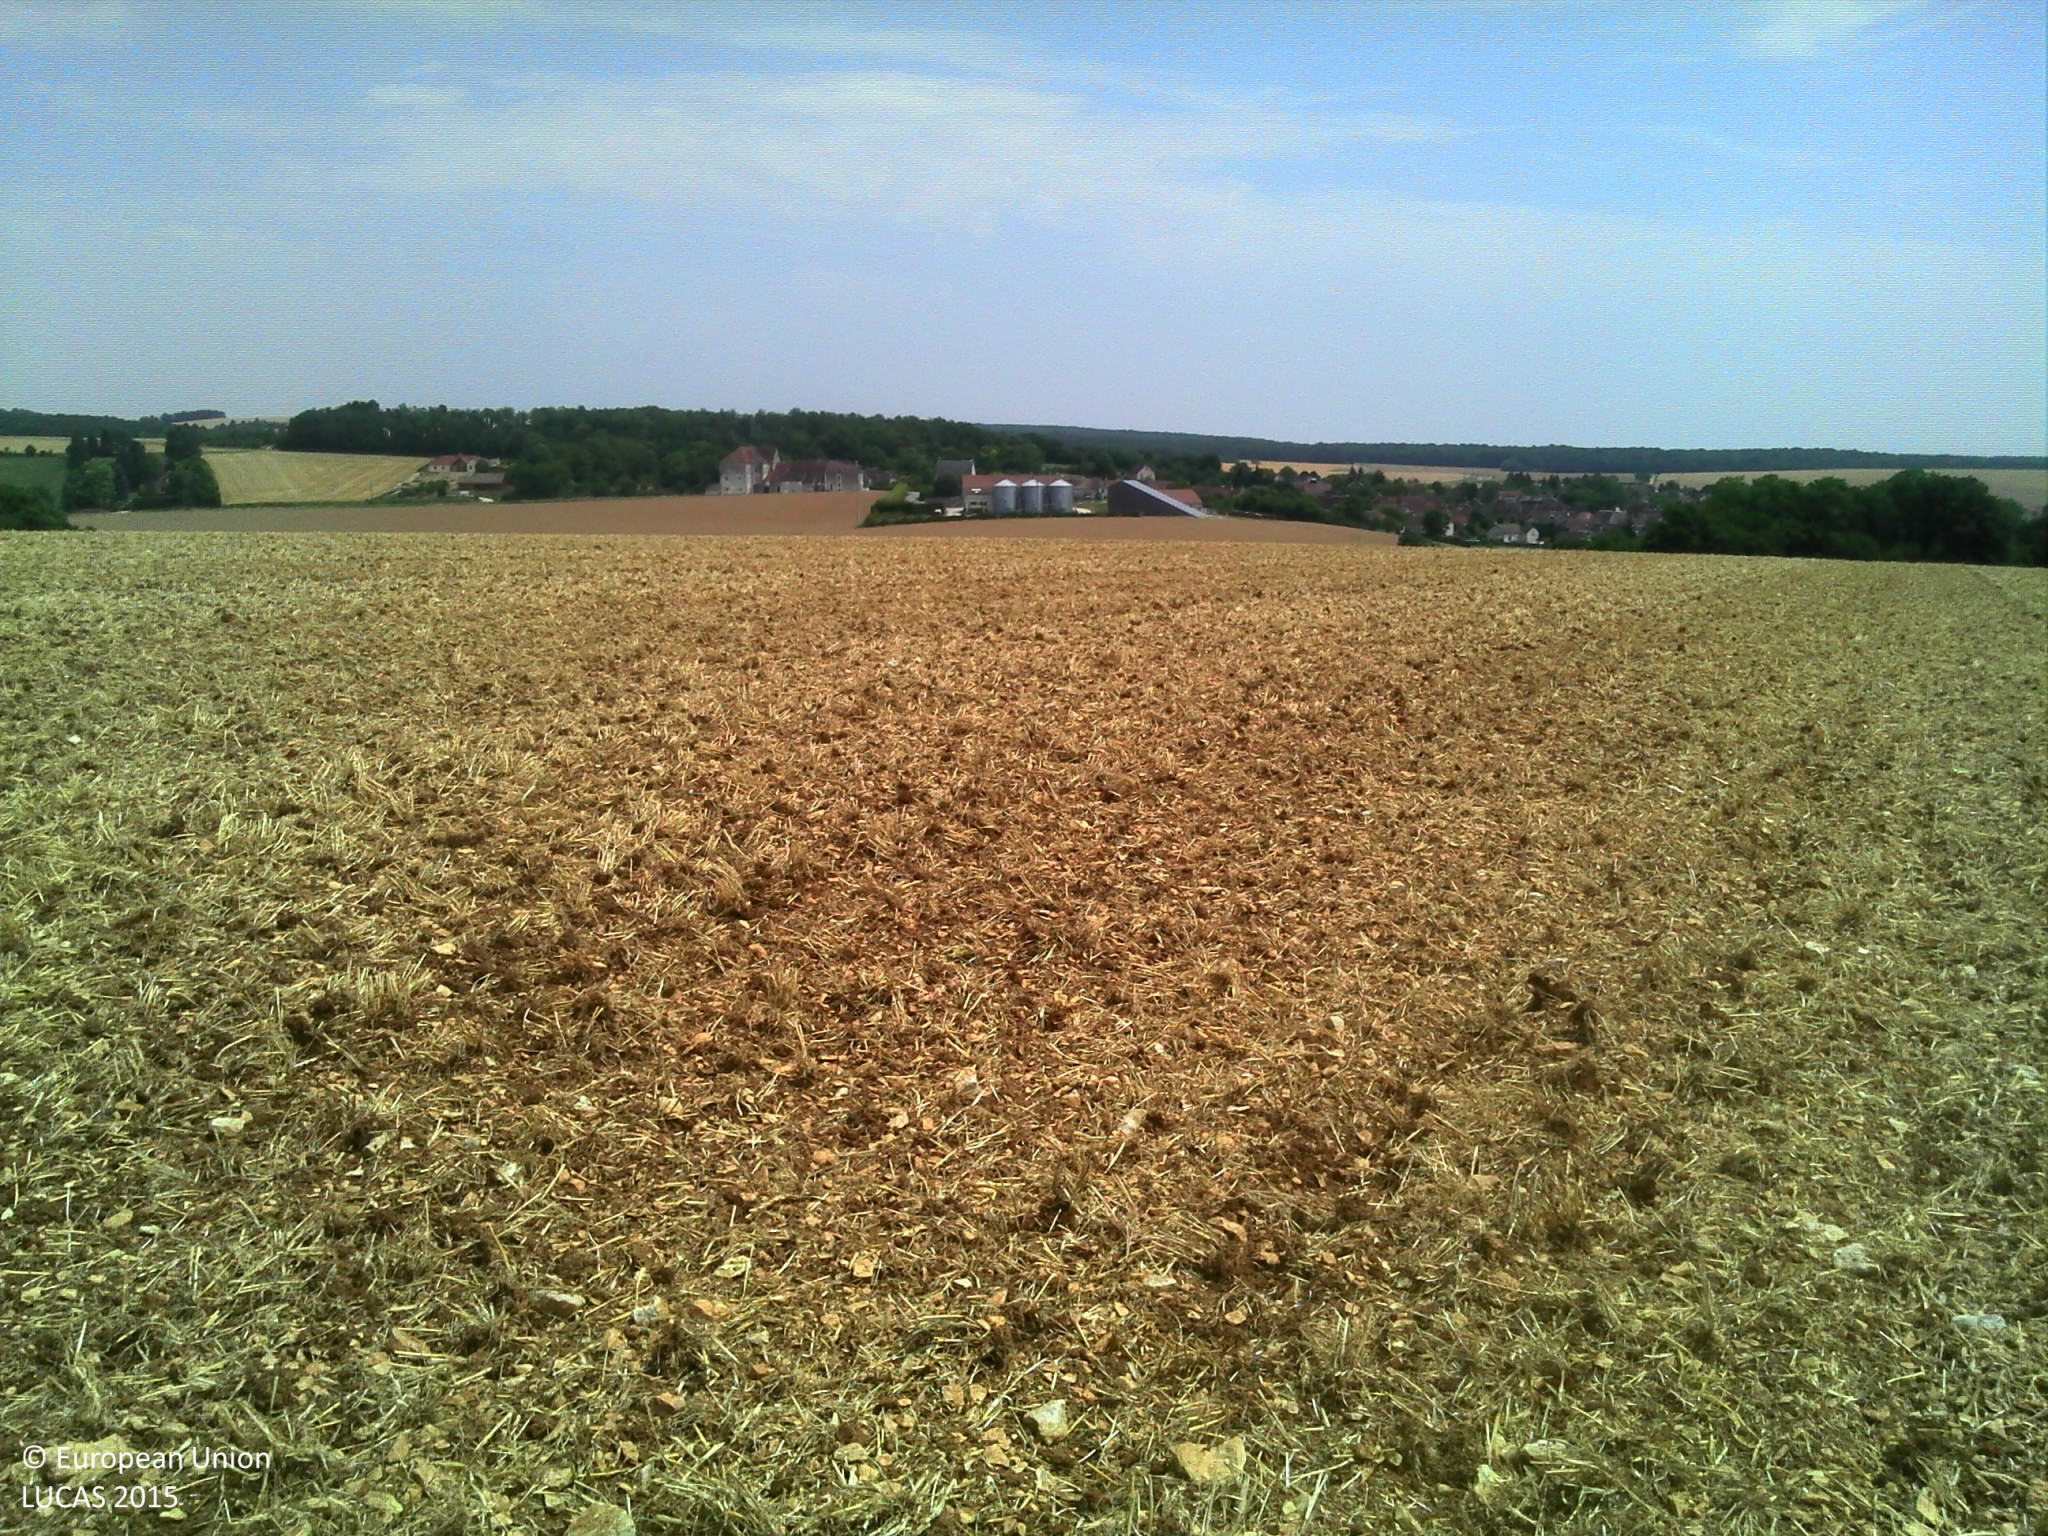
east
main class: Cropland
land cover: Barley
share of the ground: > 75 %
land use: Agriculture (excluding fallow land and kitchen gardens)
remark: Harvested field
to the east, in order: Barley
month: July
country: FR
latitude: 47.6158
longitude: 3.4900
